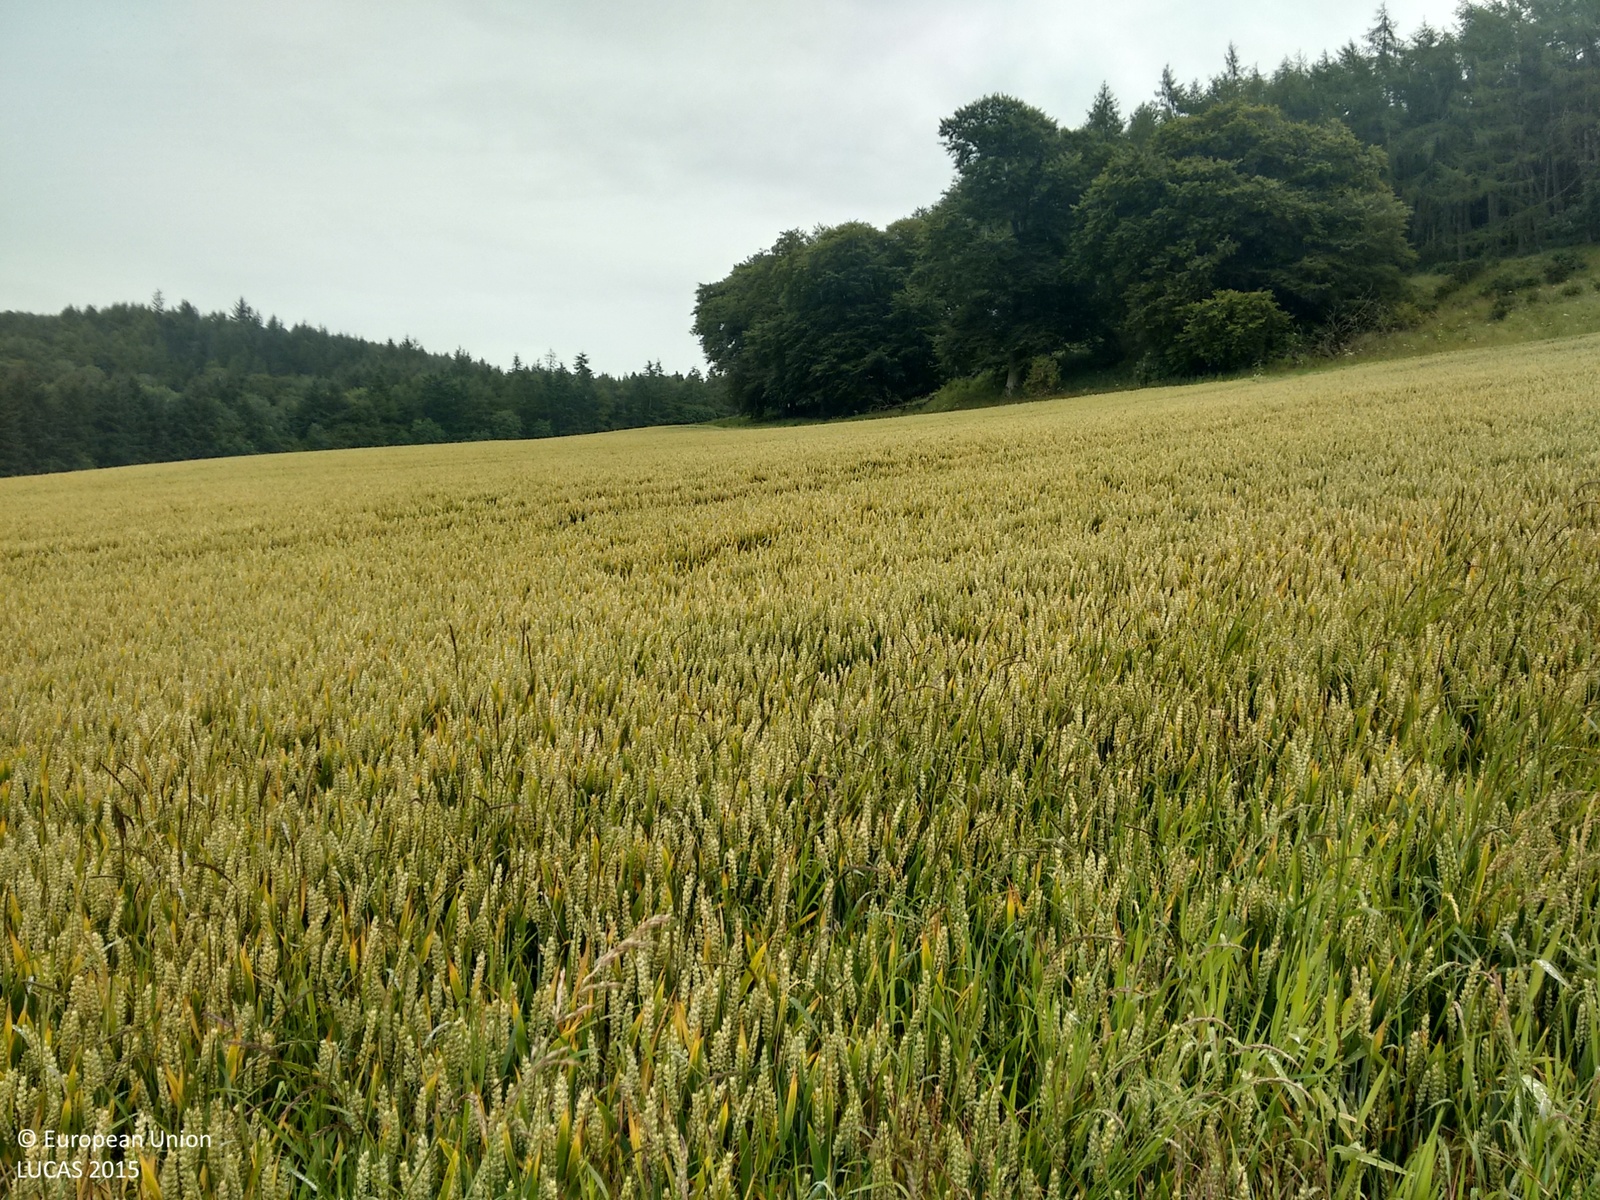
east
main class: Cropland
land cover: Common wheat
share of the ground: > 75 %
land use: Agriculture (excluding fallow land and kitchen gardens)
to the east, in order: Artificial constructions; Grass margins; Common wheat; Spontaneously vegetated surfaces; Fences; Other mixed woodland; Fences; Spontaneously vegetated surfaces
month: July
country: GB
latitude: 56.3907
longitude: -3.0752
